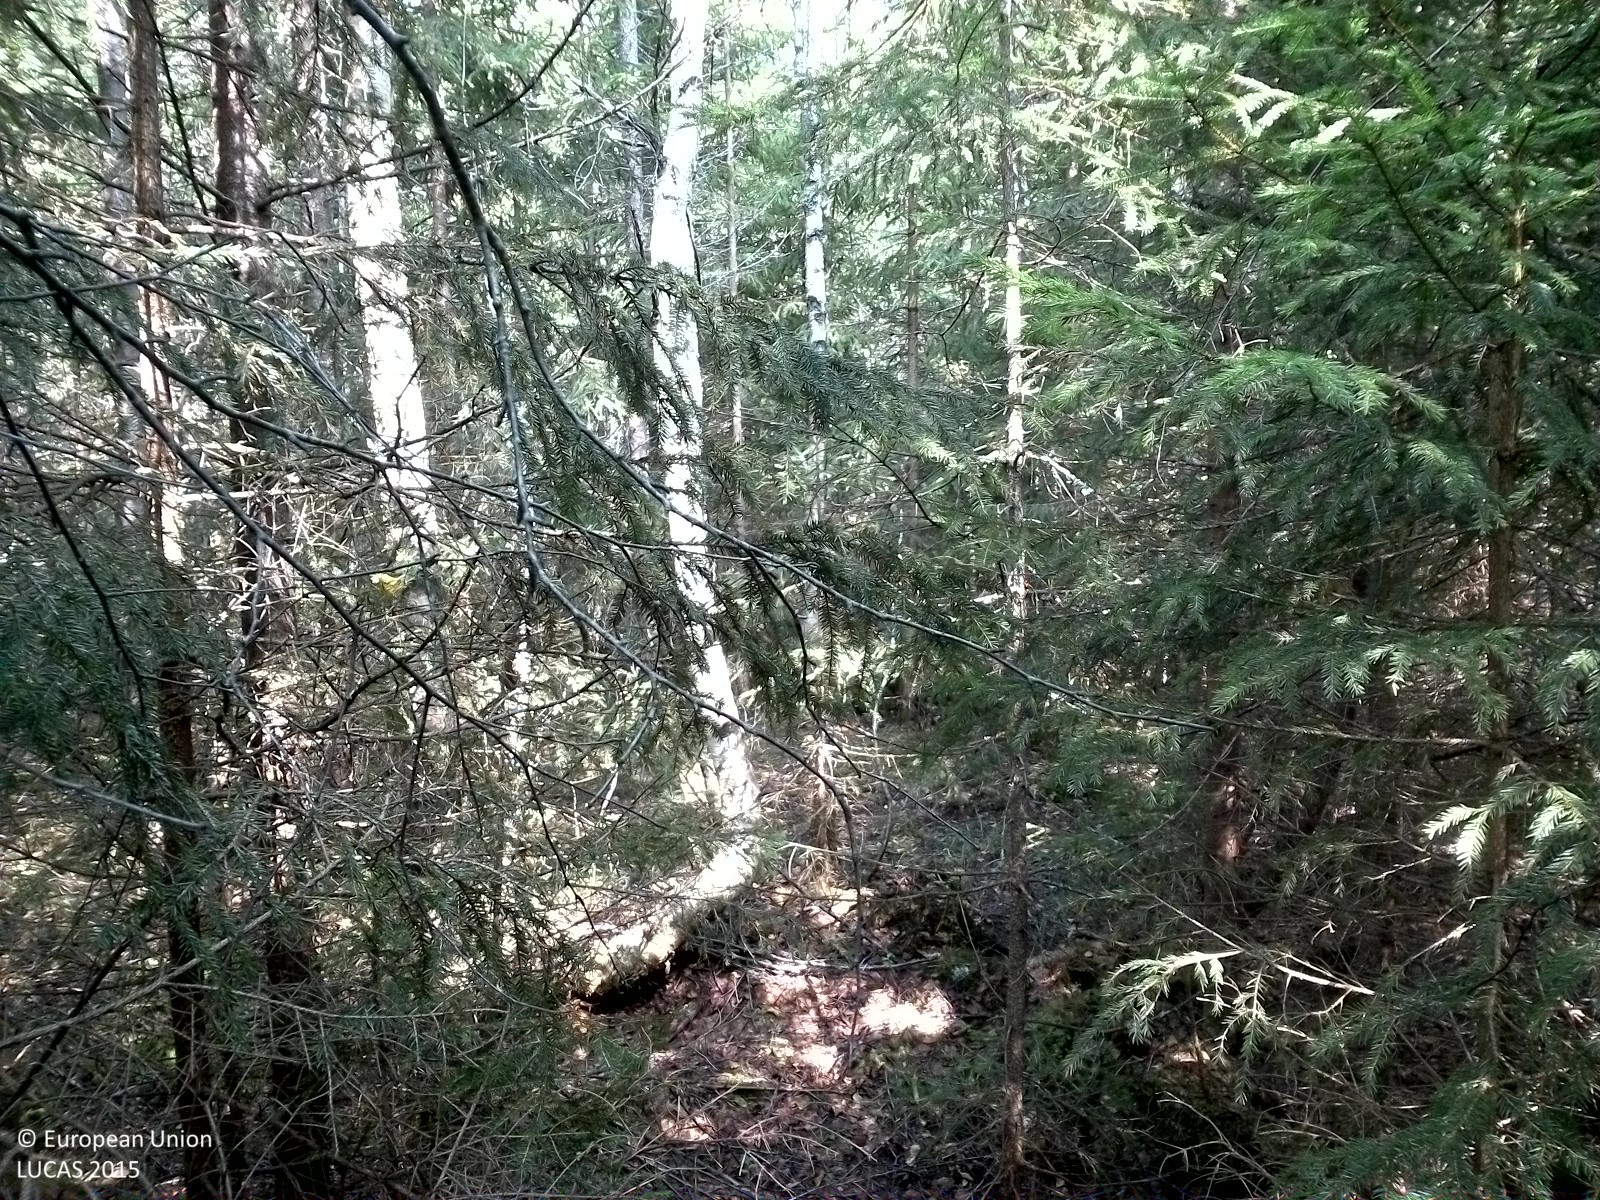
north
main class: Woodland
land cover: Spruce dominated mixed woodland
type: boreal forest
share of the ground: 50 - 75 %
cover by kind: coniferous forest trees 40 %, broadleaved forest trees 25 %, consolidated bare surface 20 %, lichens and mosses 10 %, herbaceous plants 5 %
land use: Forestry
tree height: < 5 m
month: August
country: SE
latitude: 59.0856
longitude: 15.3846
